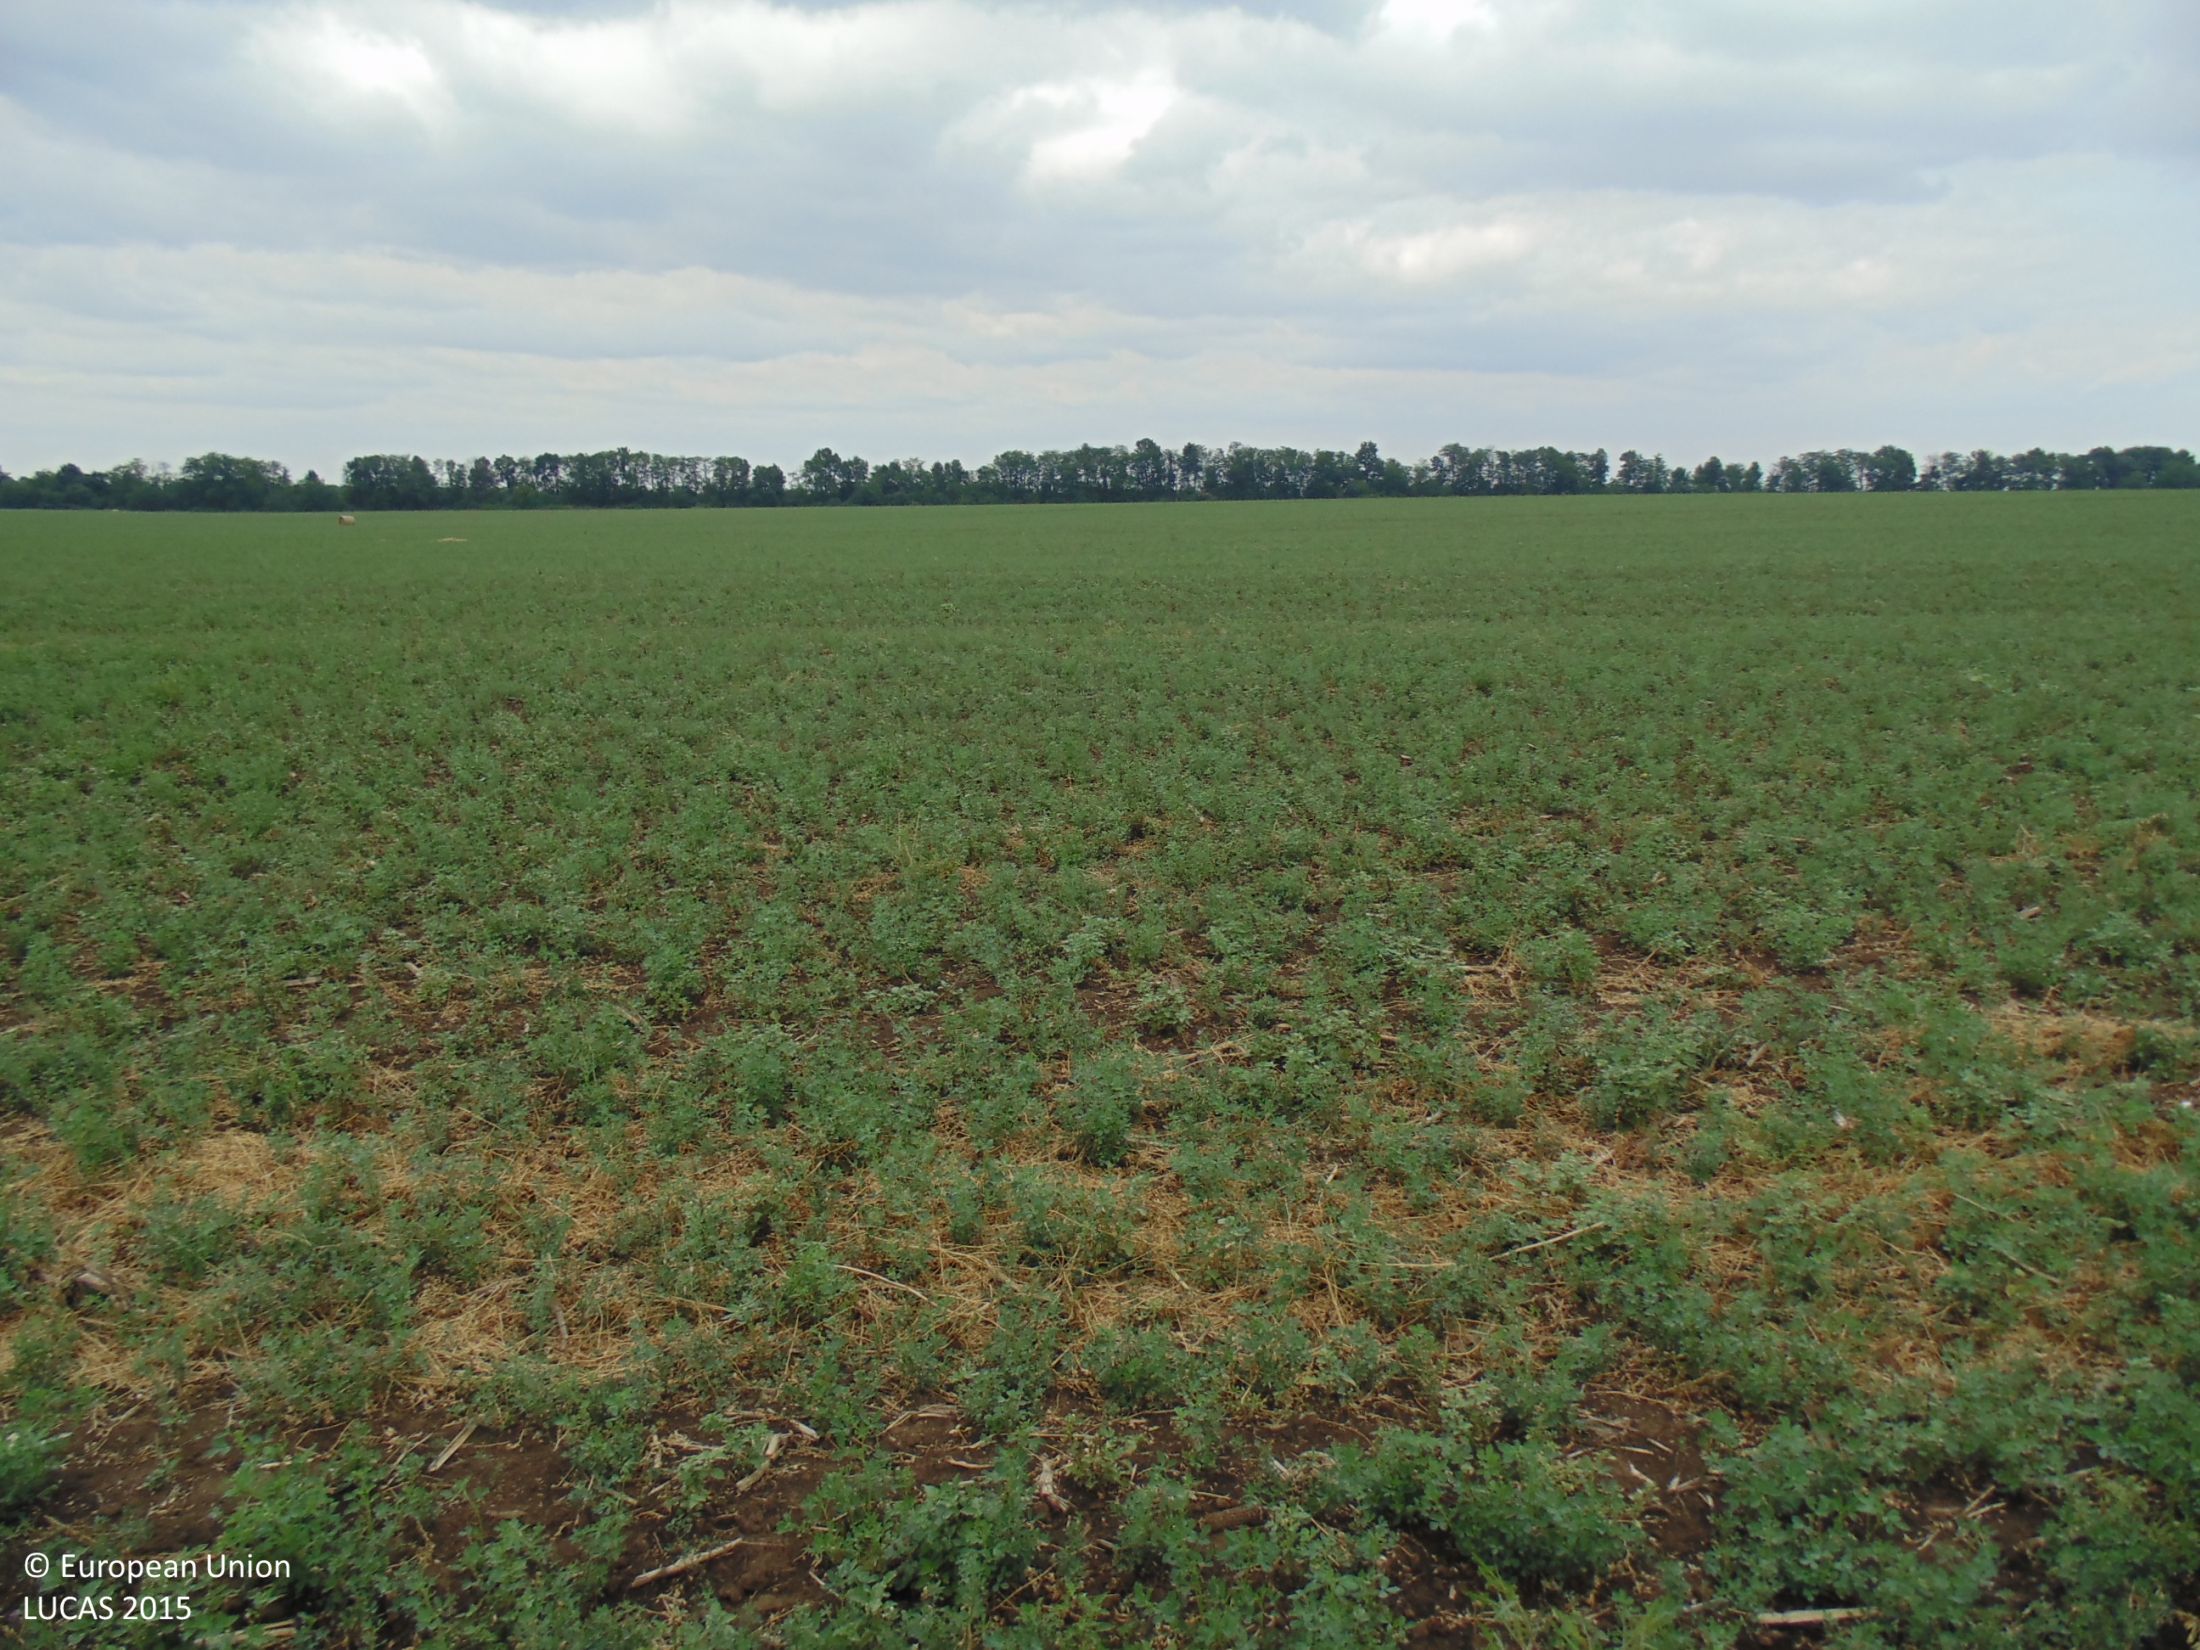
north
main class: Cropland
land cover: Lucerne
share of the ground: > 75 %
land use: Agriculture (excluding fallow land and kitchen gardens)
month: August
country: BG
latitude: 43.8659
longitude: 27.9033
